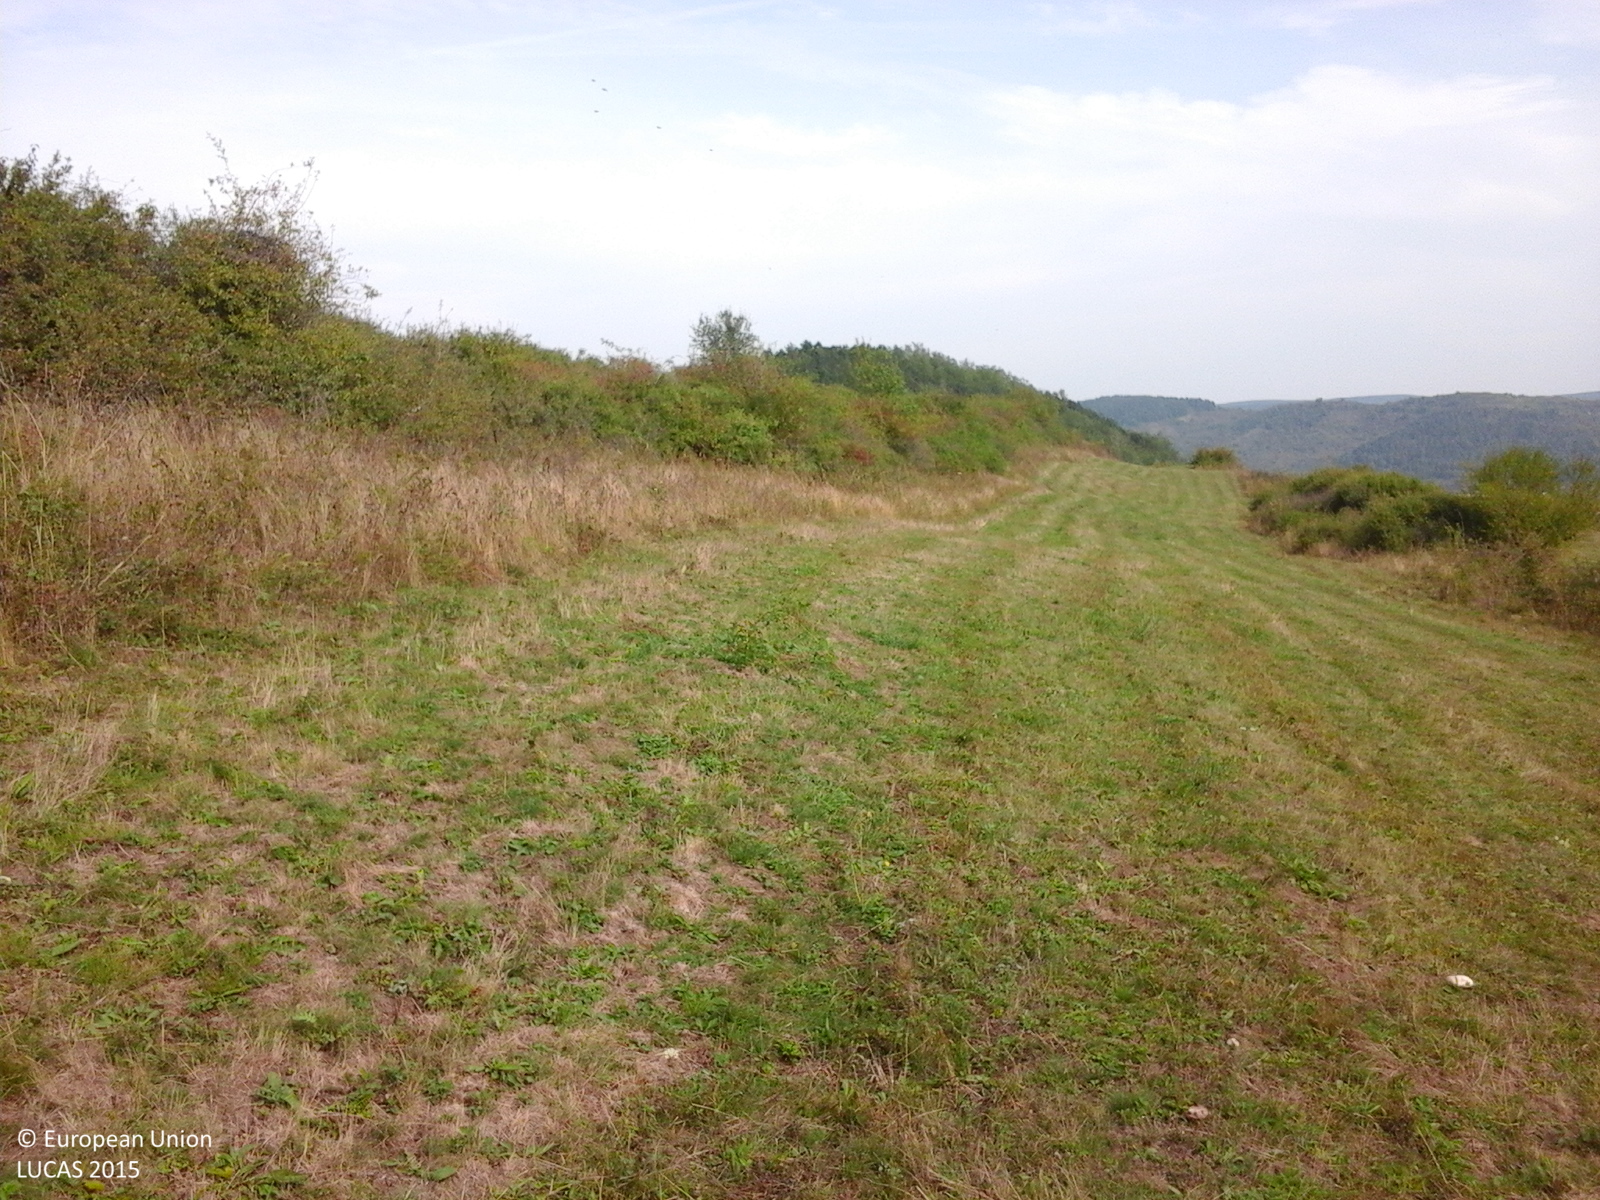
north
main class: Grassland
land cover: Grassland without tree/shrub cover
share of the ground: > 75 %
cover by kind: herbaceous plants 100 %
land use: Agriculture (excluding fallow land and kitchen gardens)
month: September
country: RO
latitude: 47.1335
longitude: 23.6405
